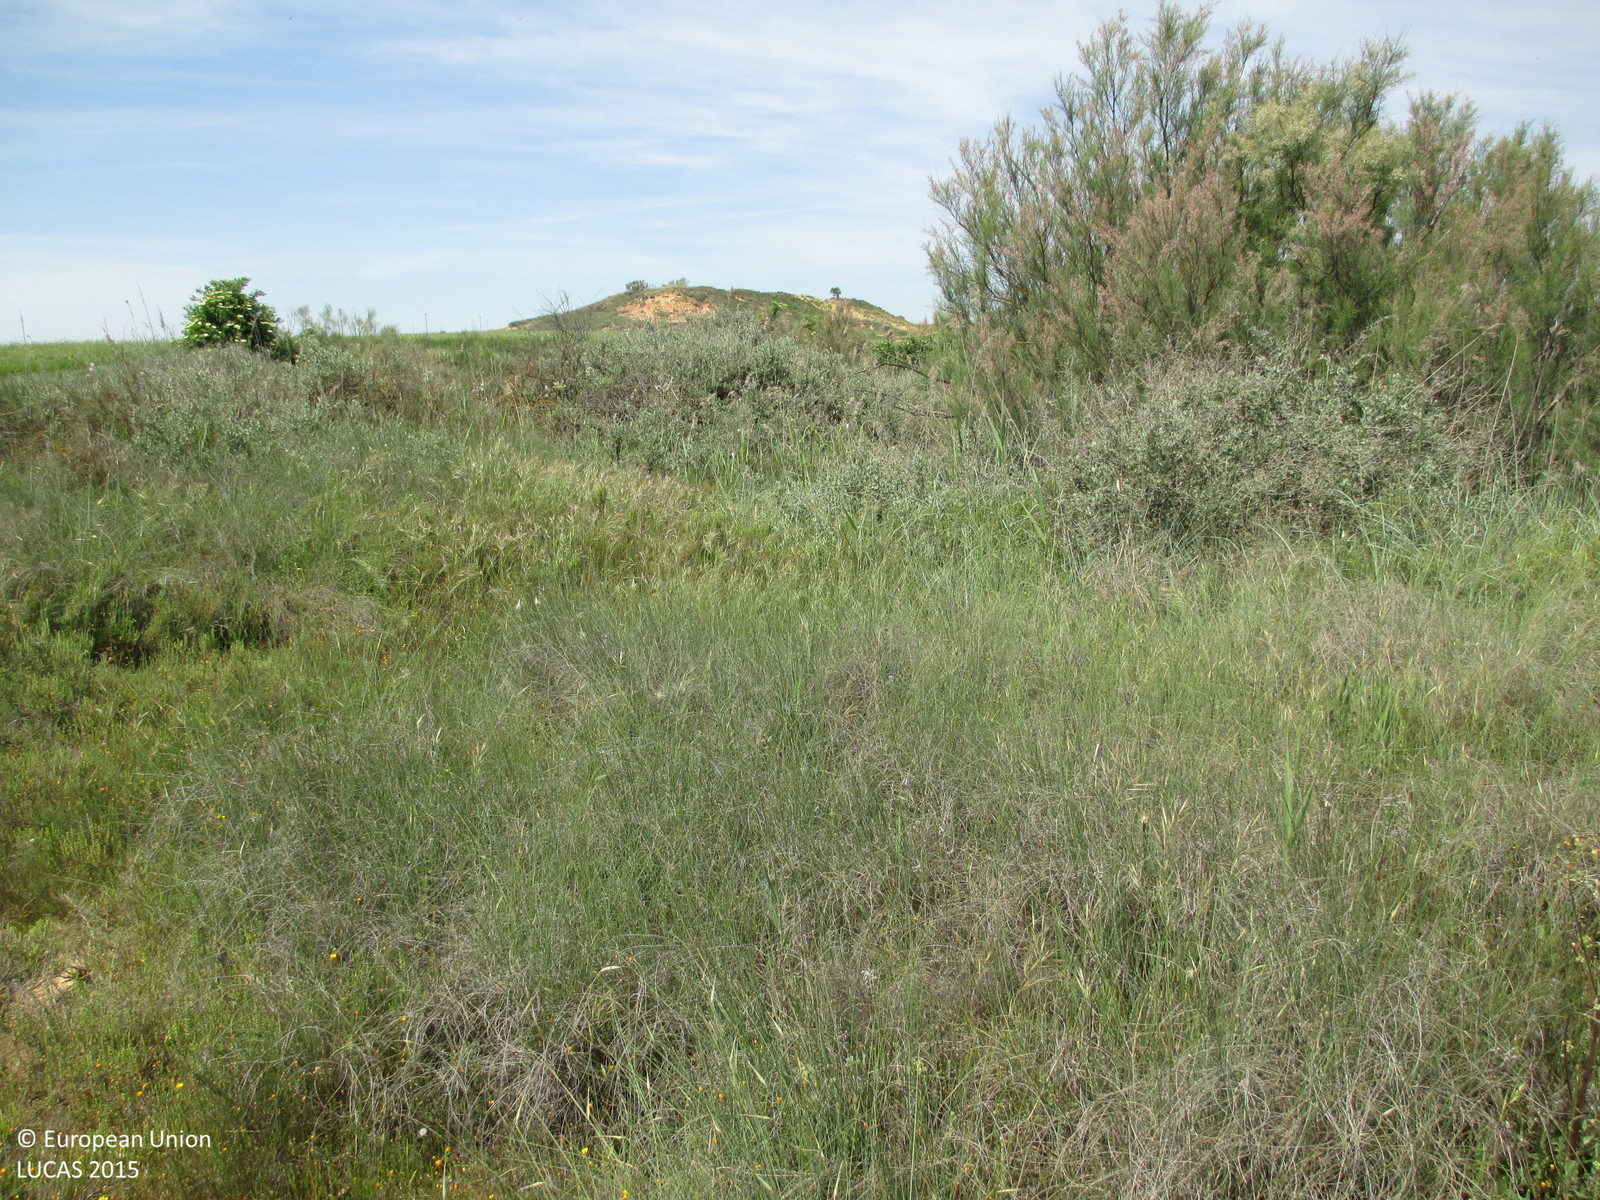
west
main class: Shrubland
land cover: Shrubland without tree cover
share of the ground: > 75 %
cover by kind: shrubs 95 %, herbaceous plants 5 %
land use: Semi-natural and natural areas not in use
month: May
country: ES
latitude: 41.8836
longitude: -0.3718
